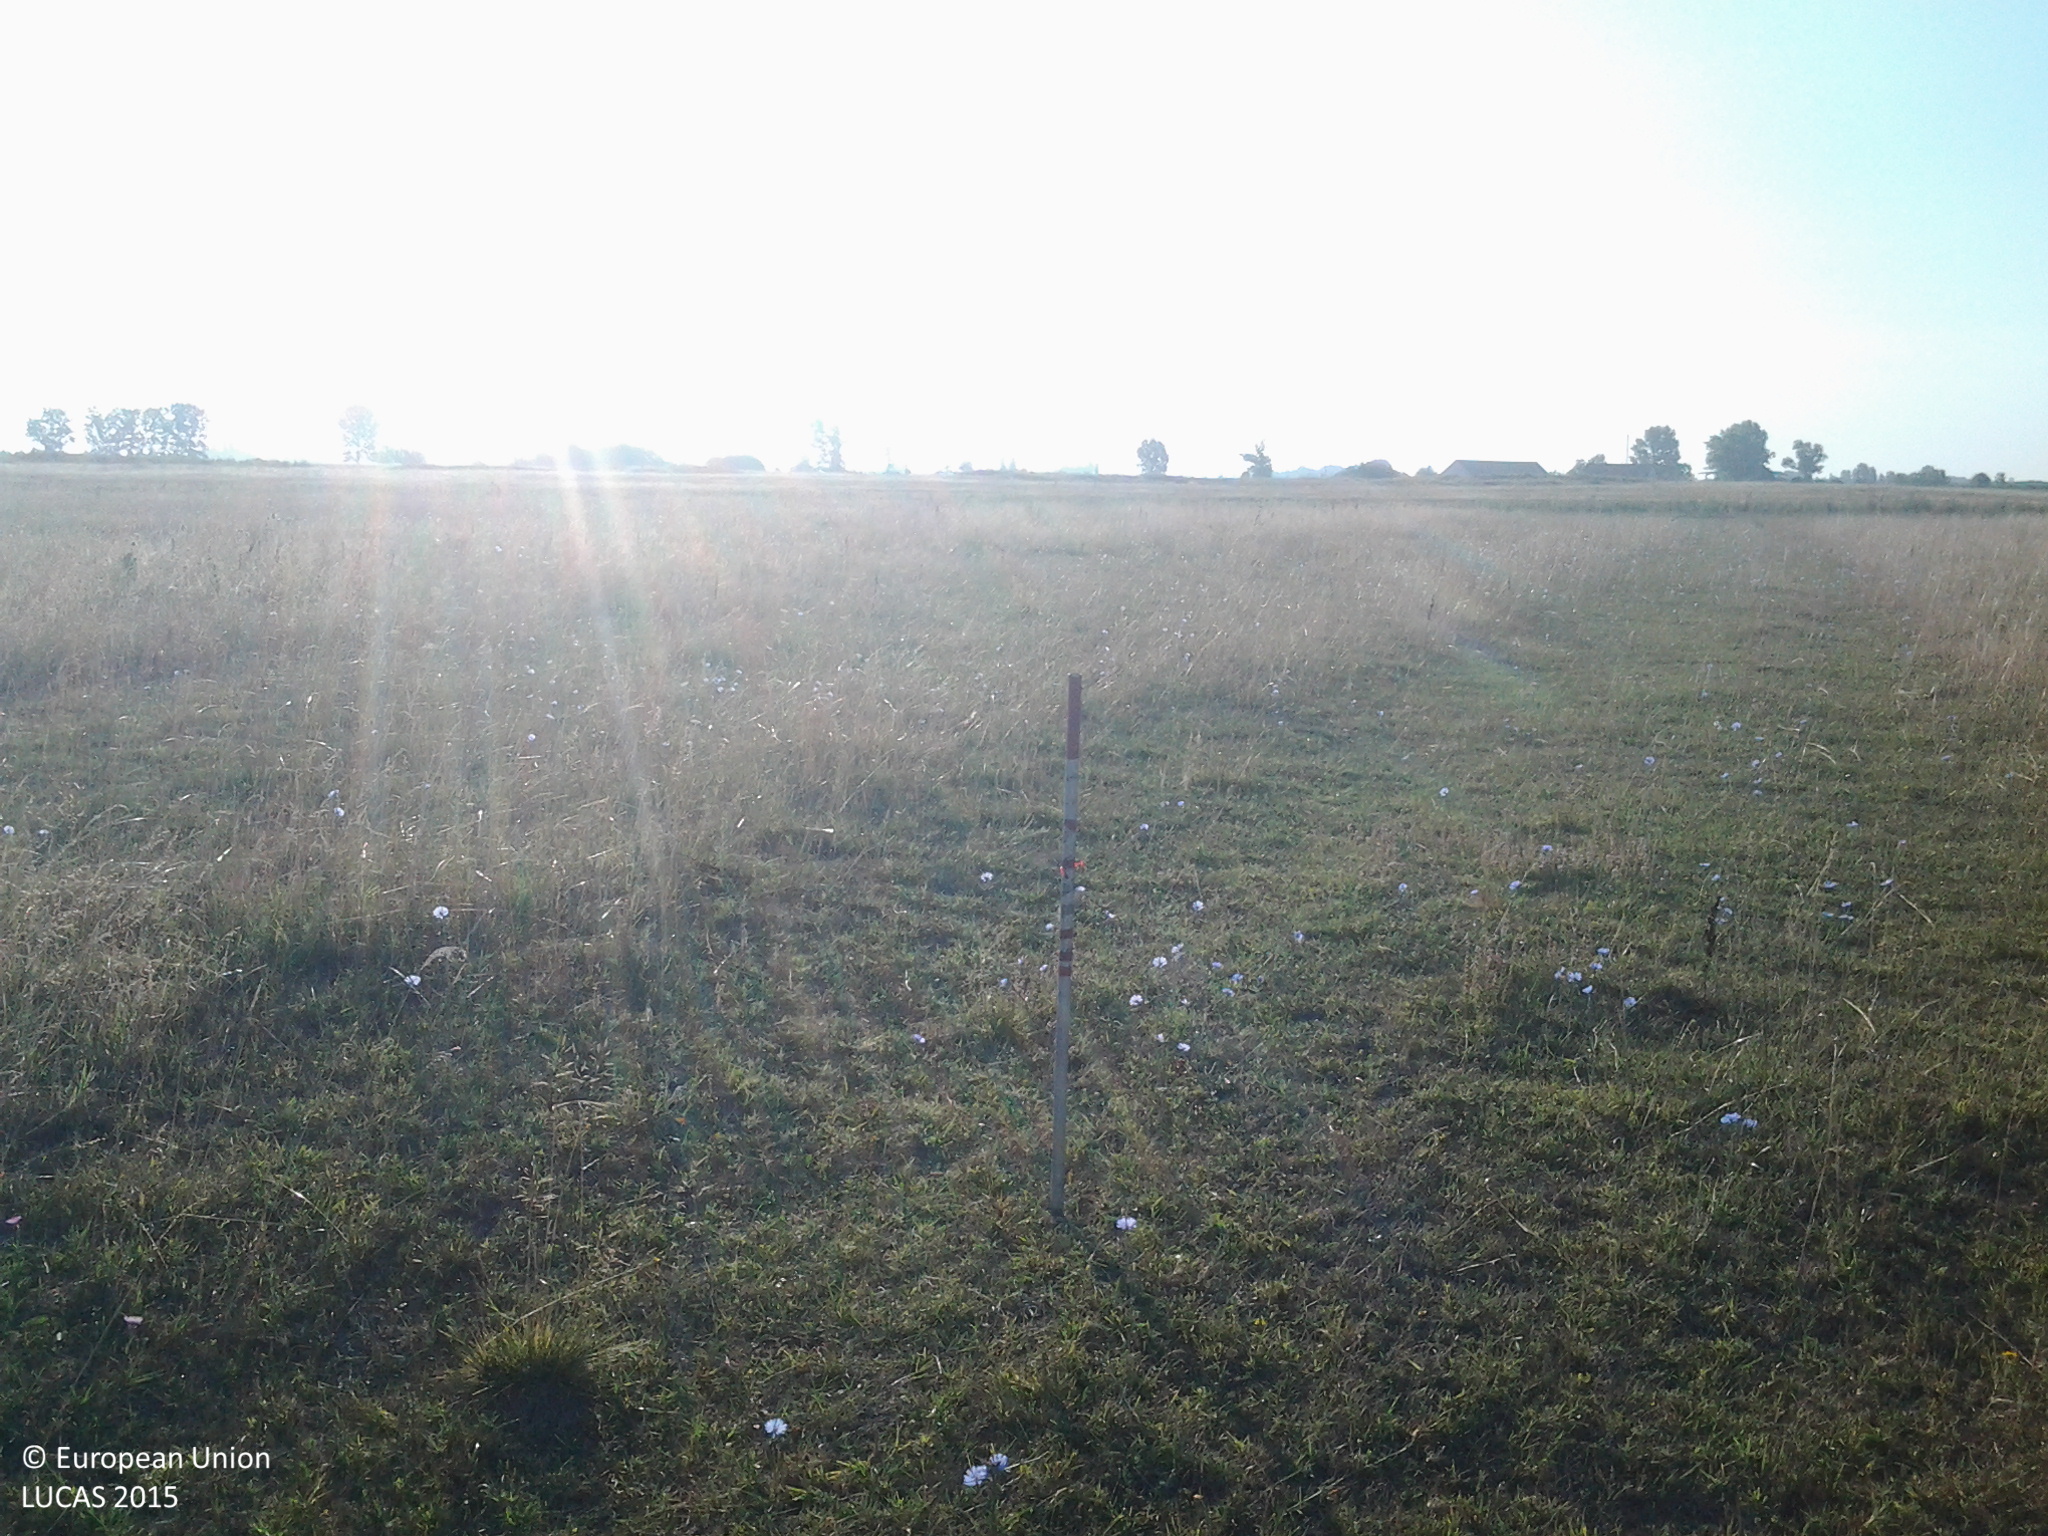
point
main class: Grassland
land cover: Grassland without tree/shrub cover
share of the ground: > 75 %
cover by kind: herbaceous plants 100 %
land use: Agriculture (excluding fallow land and kitchen gardens)
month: July
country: HU
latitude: 46.7676
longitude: 19.2218
